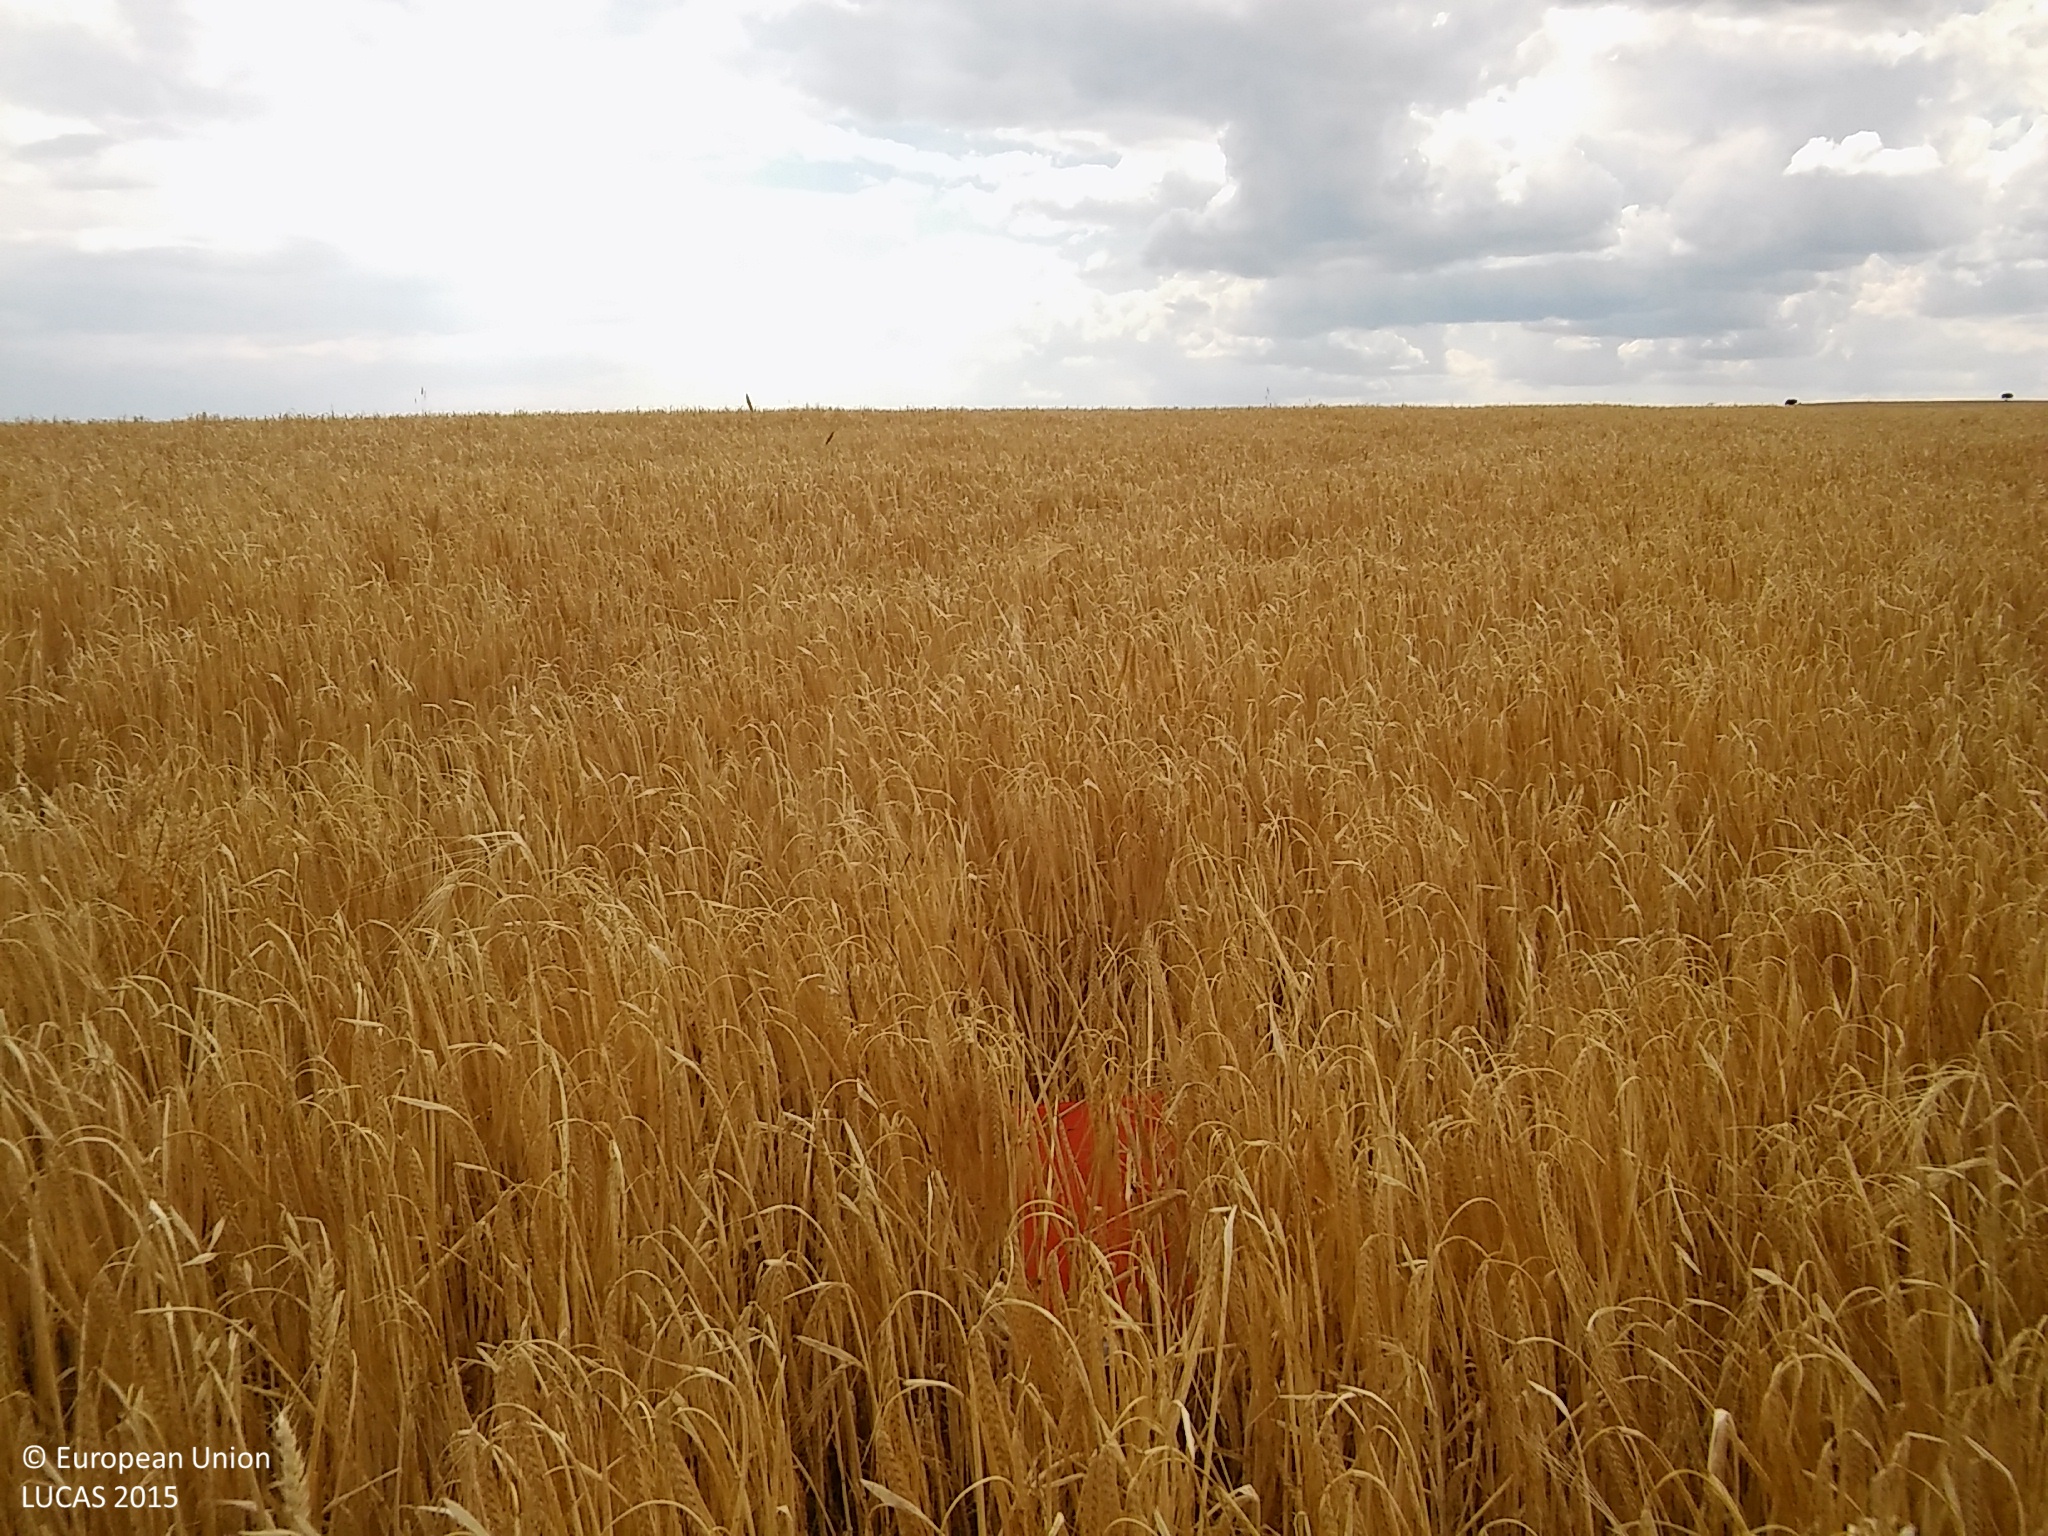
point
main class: Cropland
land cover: Barley
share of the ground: > 75 %
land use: Agriculture (excluding fallow land and kitchen gardens)
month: June
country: ES
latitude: 41.3363
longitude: -3.6830
